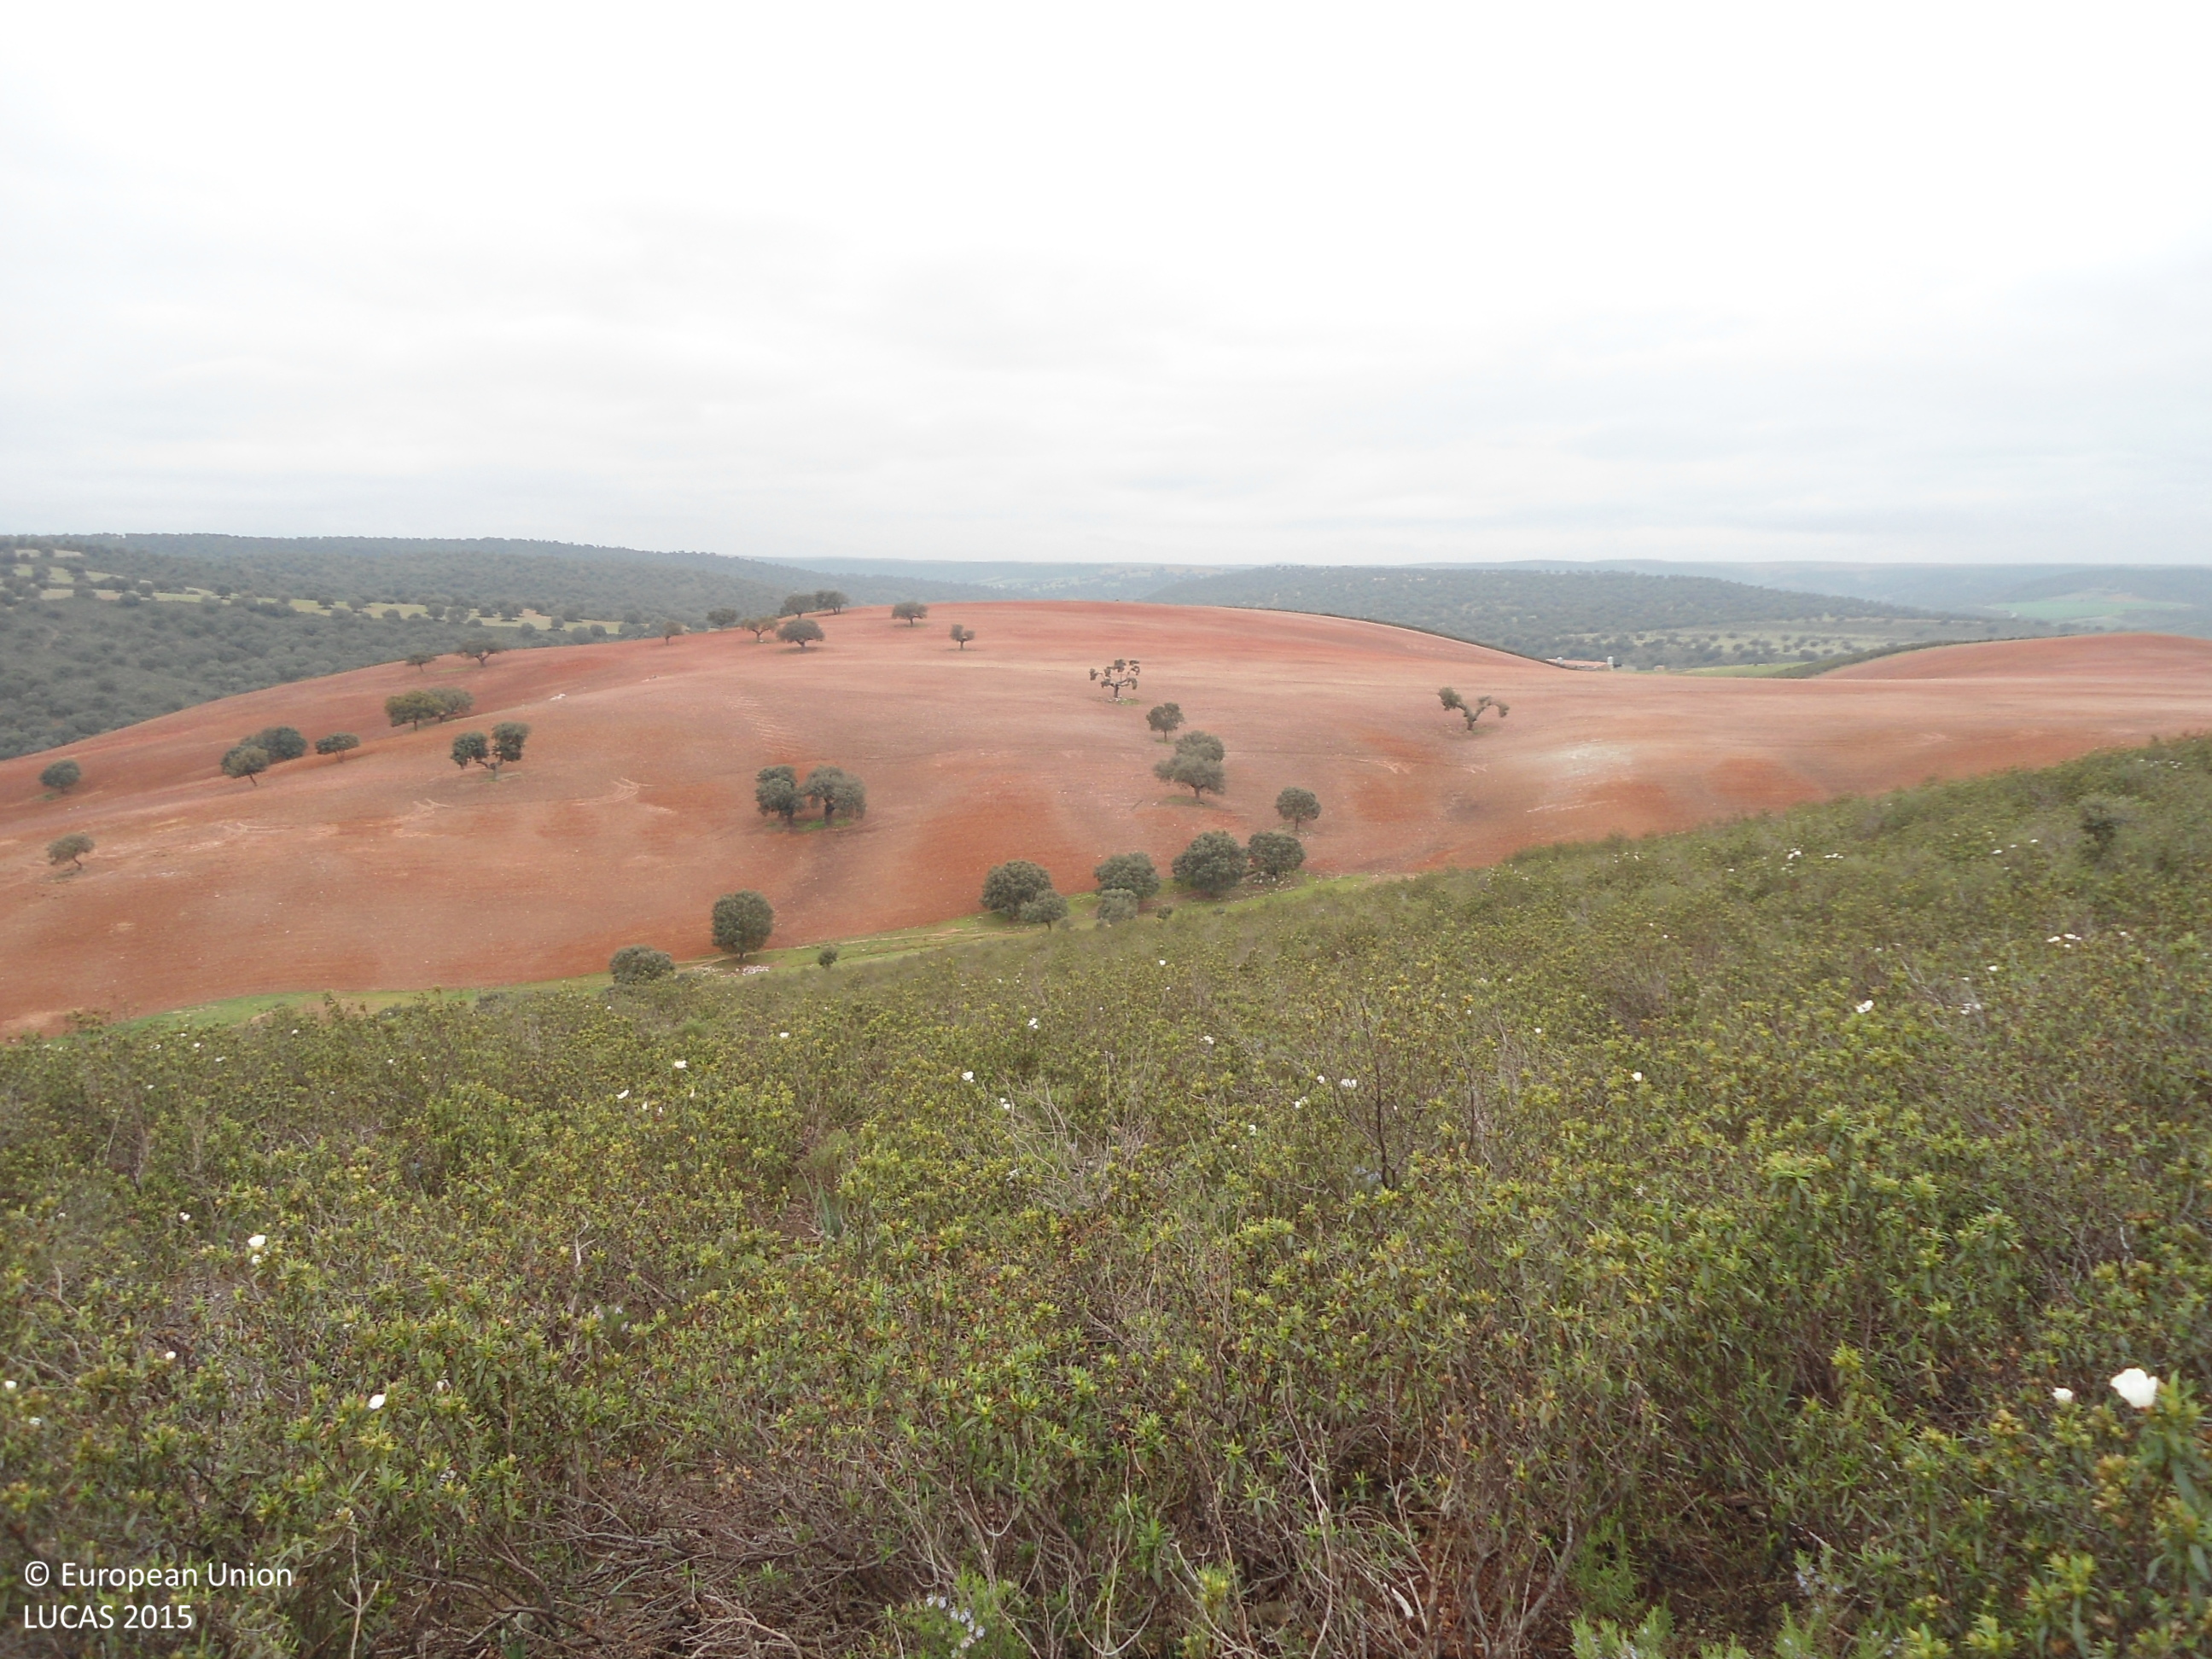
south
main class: Shrubland
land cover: Shrubland without tree cover
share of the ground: > 75 %
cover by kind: shrubs 100 %
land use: Abandoned areas
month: April
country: ES
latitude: 41.5256
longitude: -5.8481
